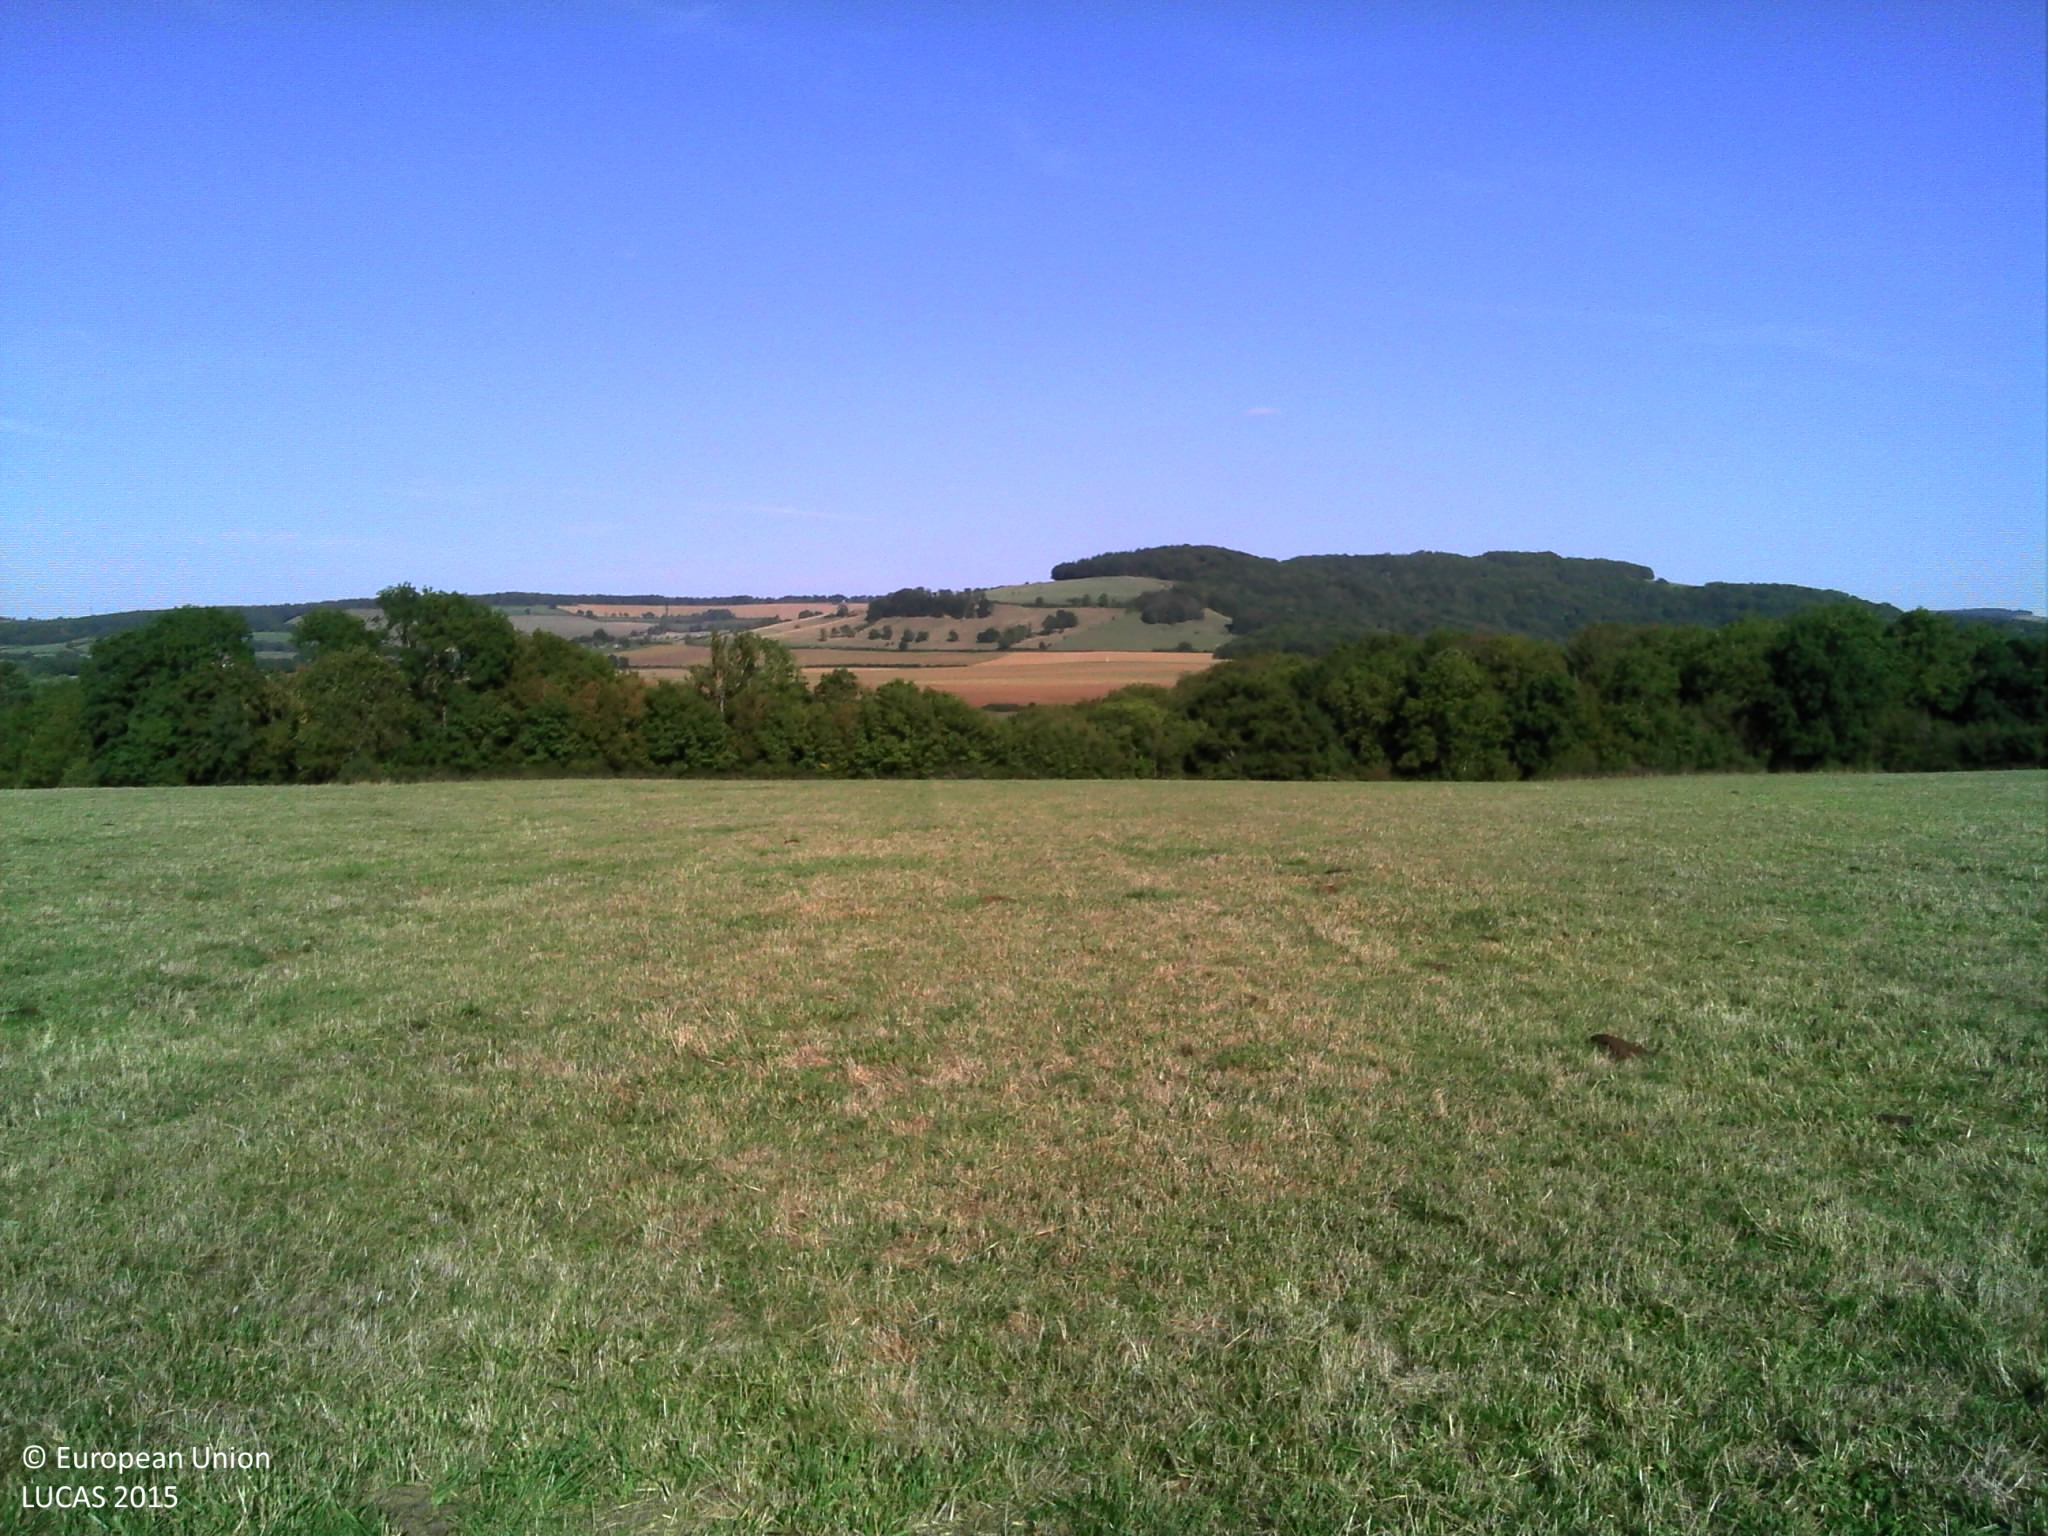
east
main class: Grassland
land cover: Grassland without tree/shrub cover
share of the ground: > 75 %
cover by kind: herbaceous plants 100 %
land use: Agriculture (excluding fallow land and kitchen gardens)
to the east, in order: Grassland without tree/shrub cover; Broadleaved woodland; Fences; Ditches and canals; Broadleaved woodland; Tracks; Broadleaved woodland
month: September
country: FR
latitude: 47.5169
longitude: 4.3017
